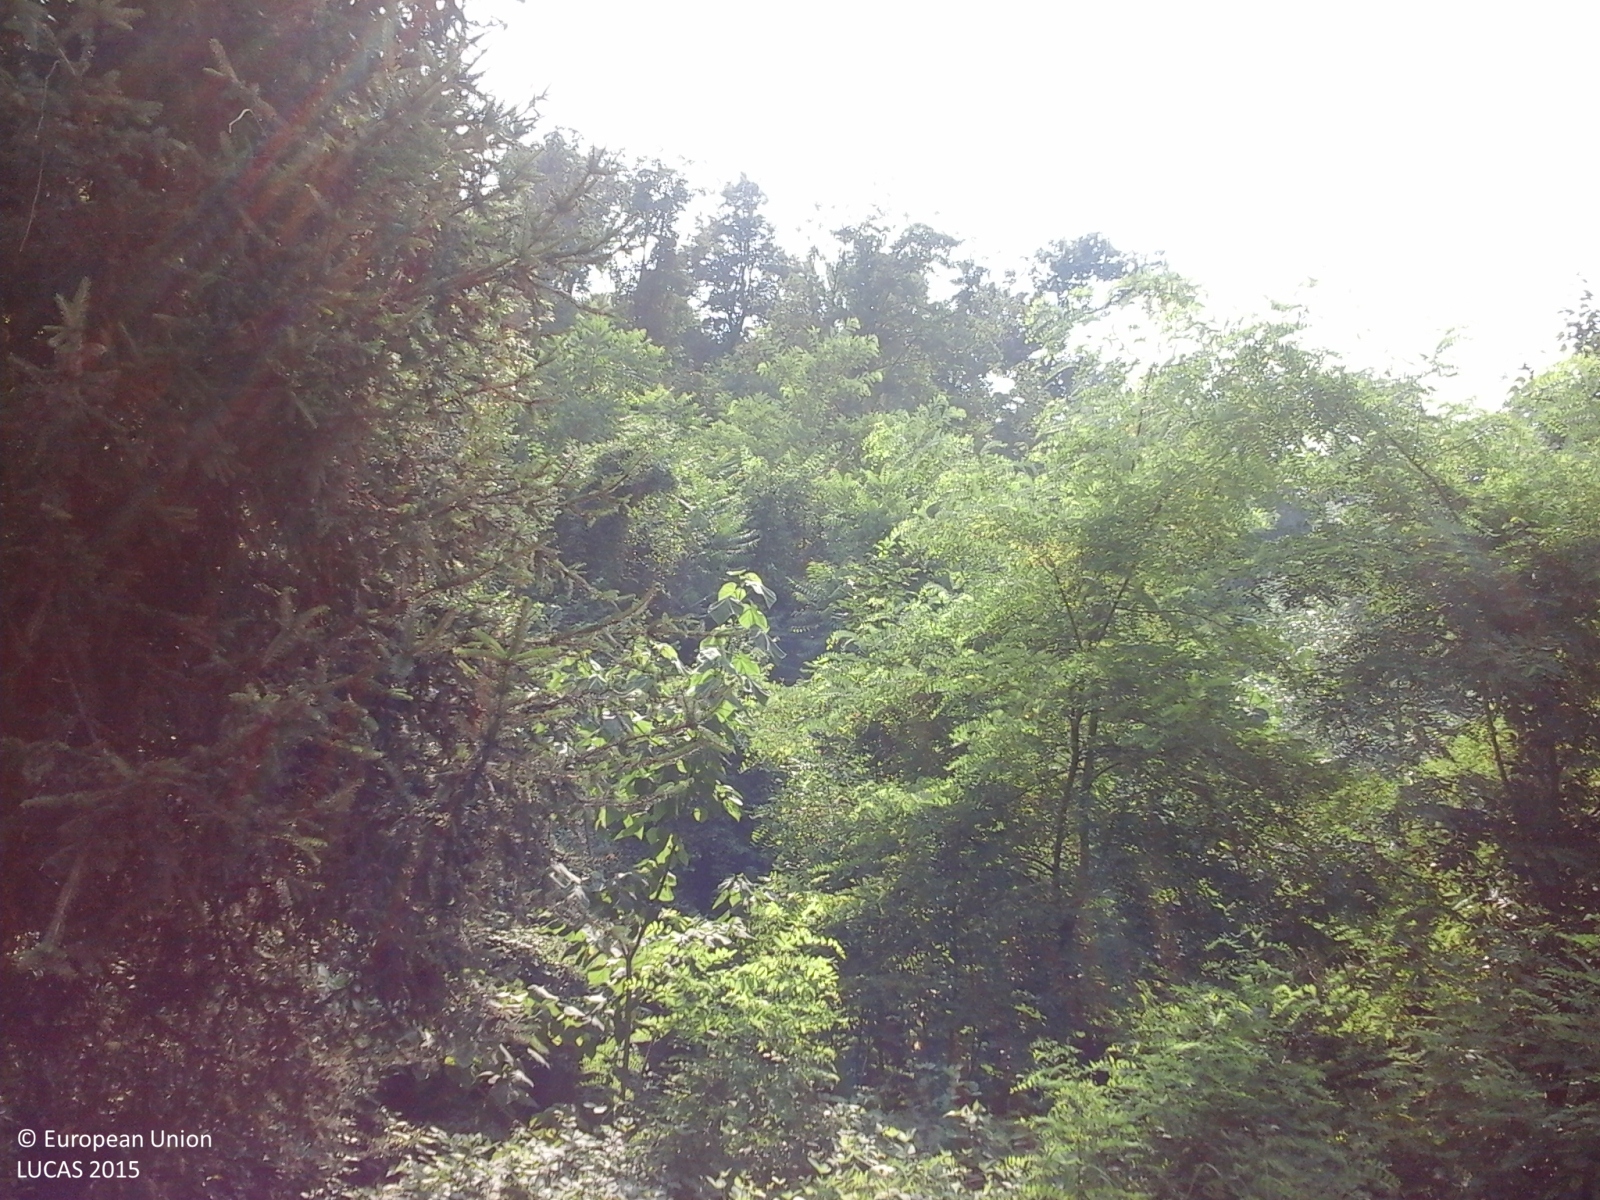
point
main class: Woodland
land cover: Broadleaved woodland
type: thermophilous deciduous forest
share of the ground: > 75 %
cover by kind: broadleaved forest trees 100 %
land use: Semi-natural and natural areas not in use
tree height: > 5 m
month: July
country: IT
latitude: 45.0653
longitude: 7.7307
